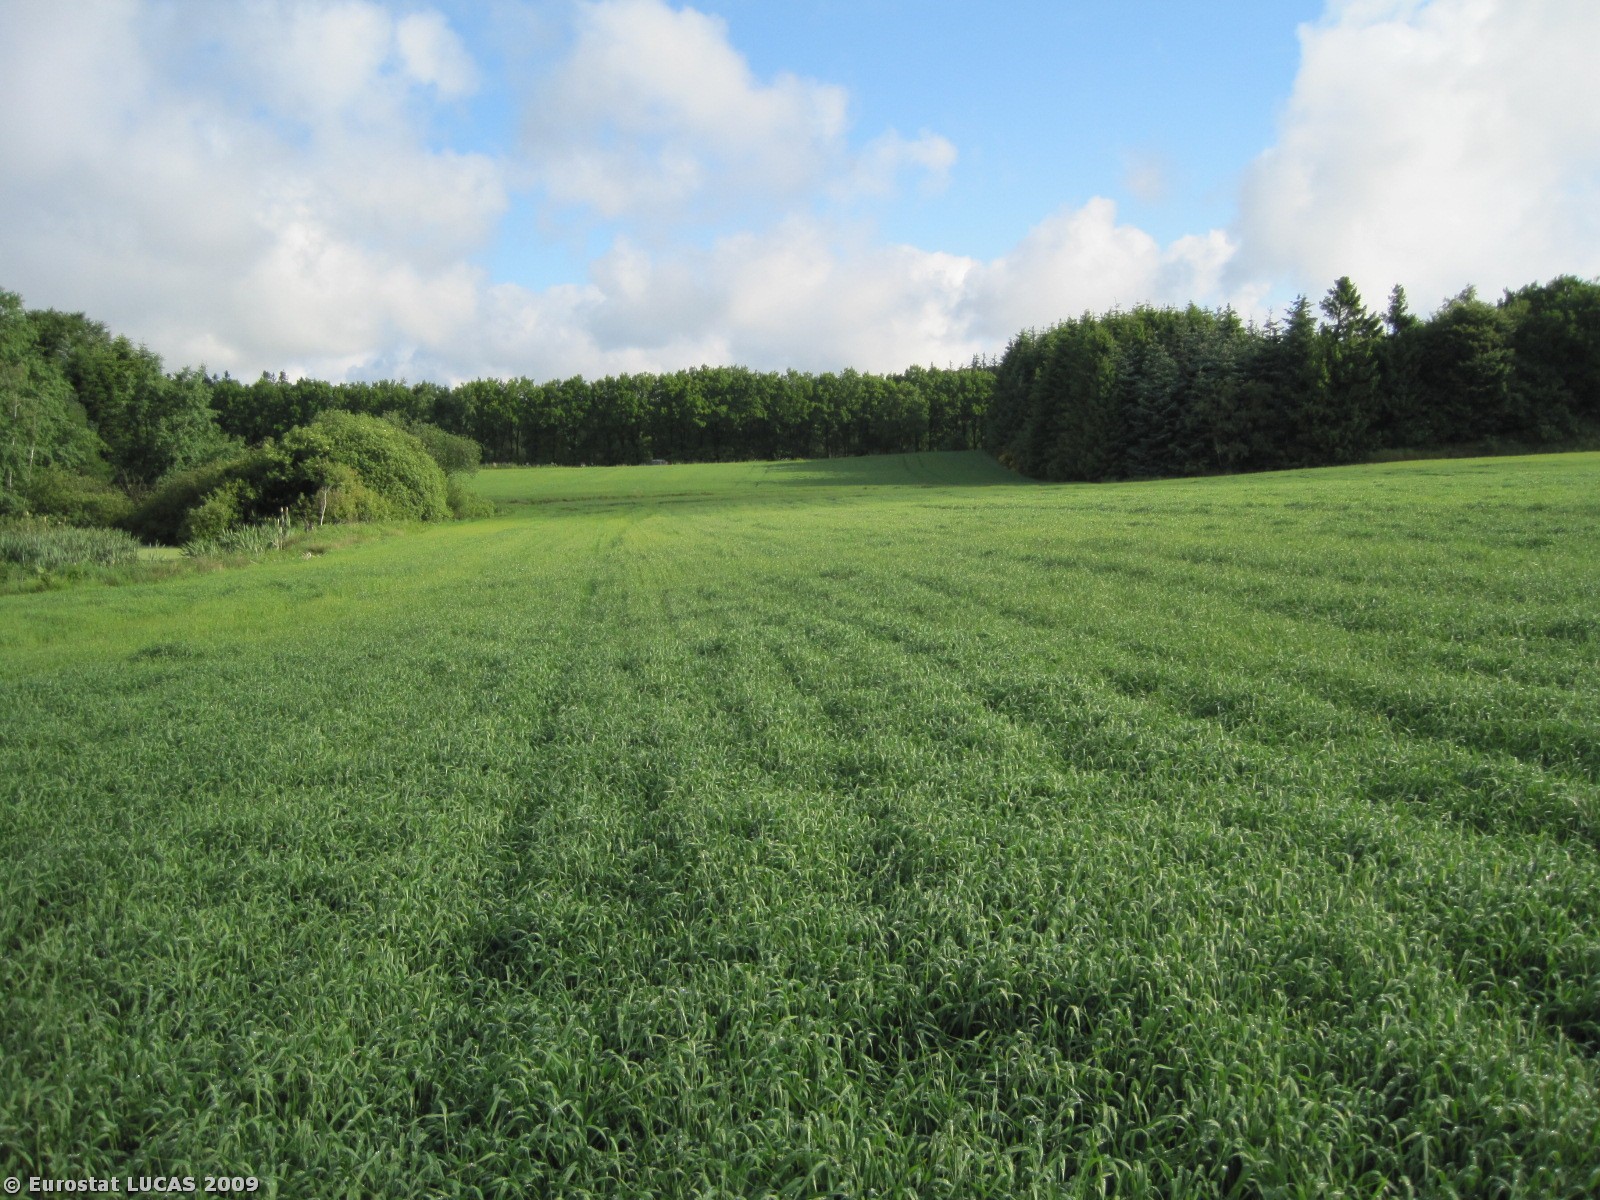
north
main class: Cropland
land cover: Barley
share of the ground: > 75 %
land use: Agriculture (excluding fallow land and kitchen gardens)
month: June
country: DK
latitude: 57.2842
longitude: 10.1822
